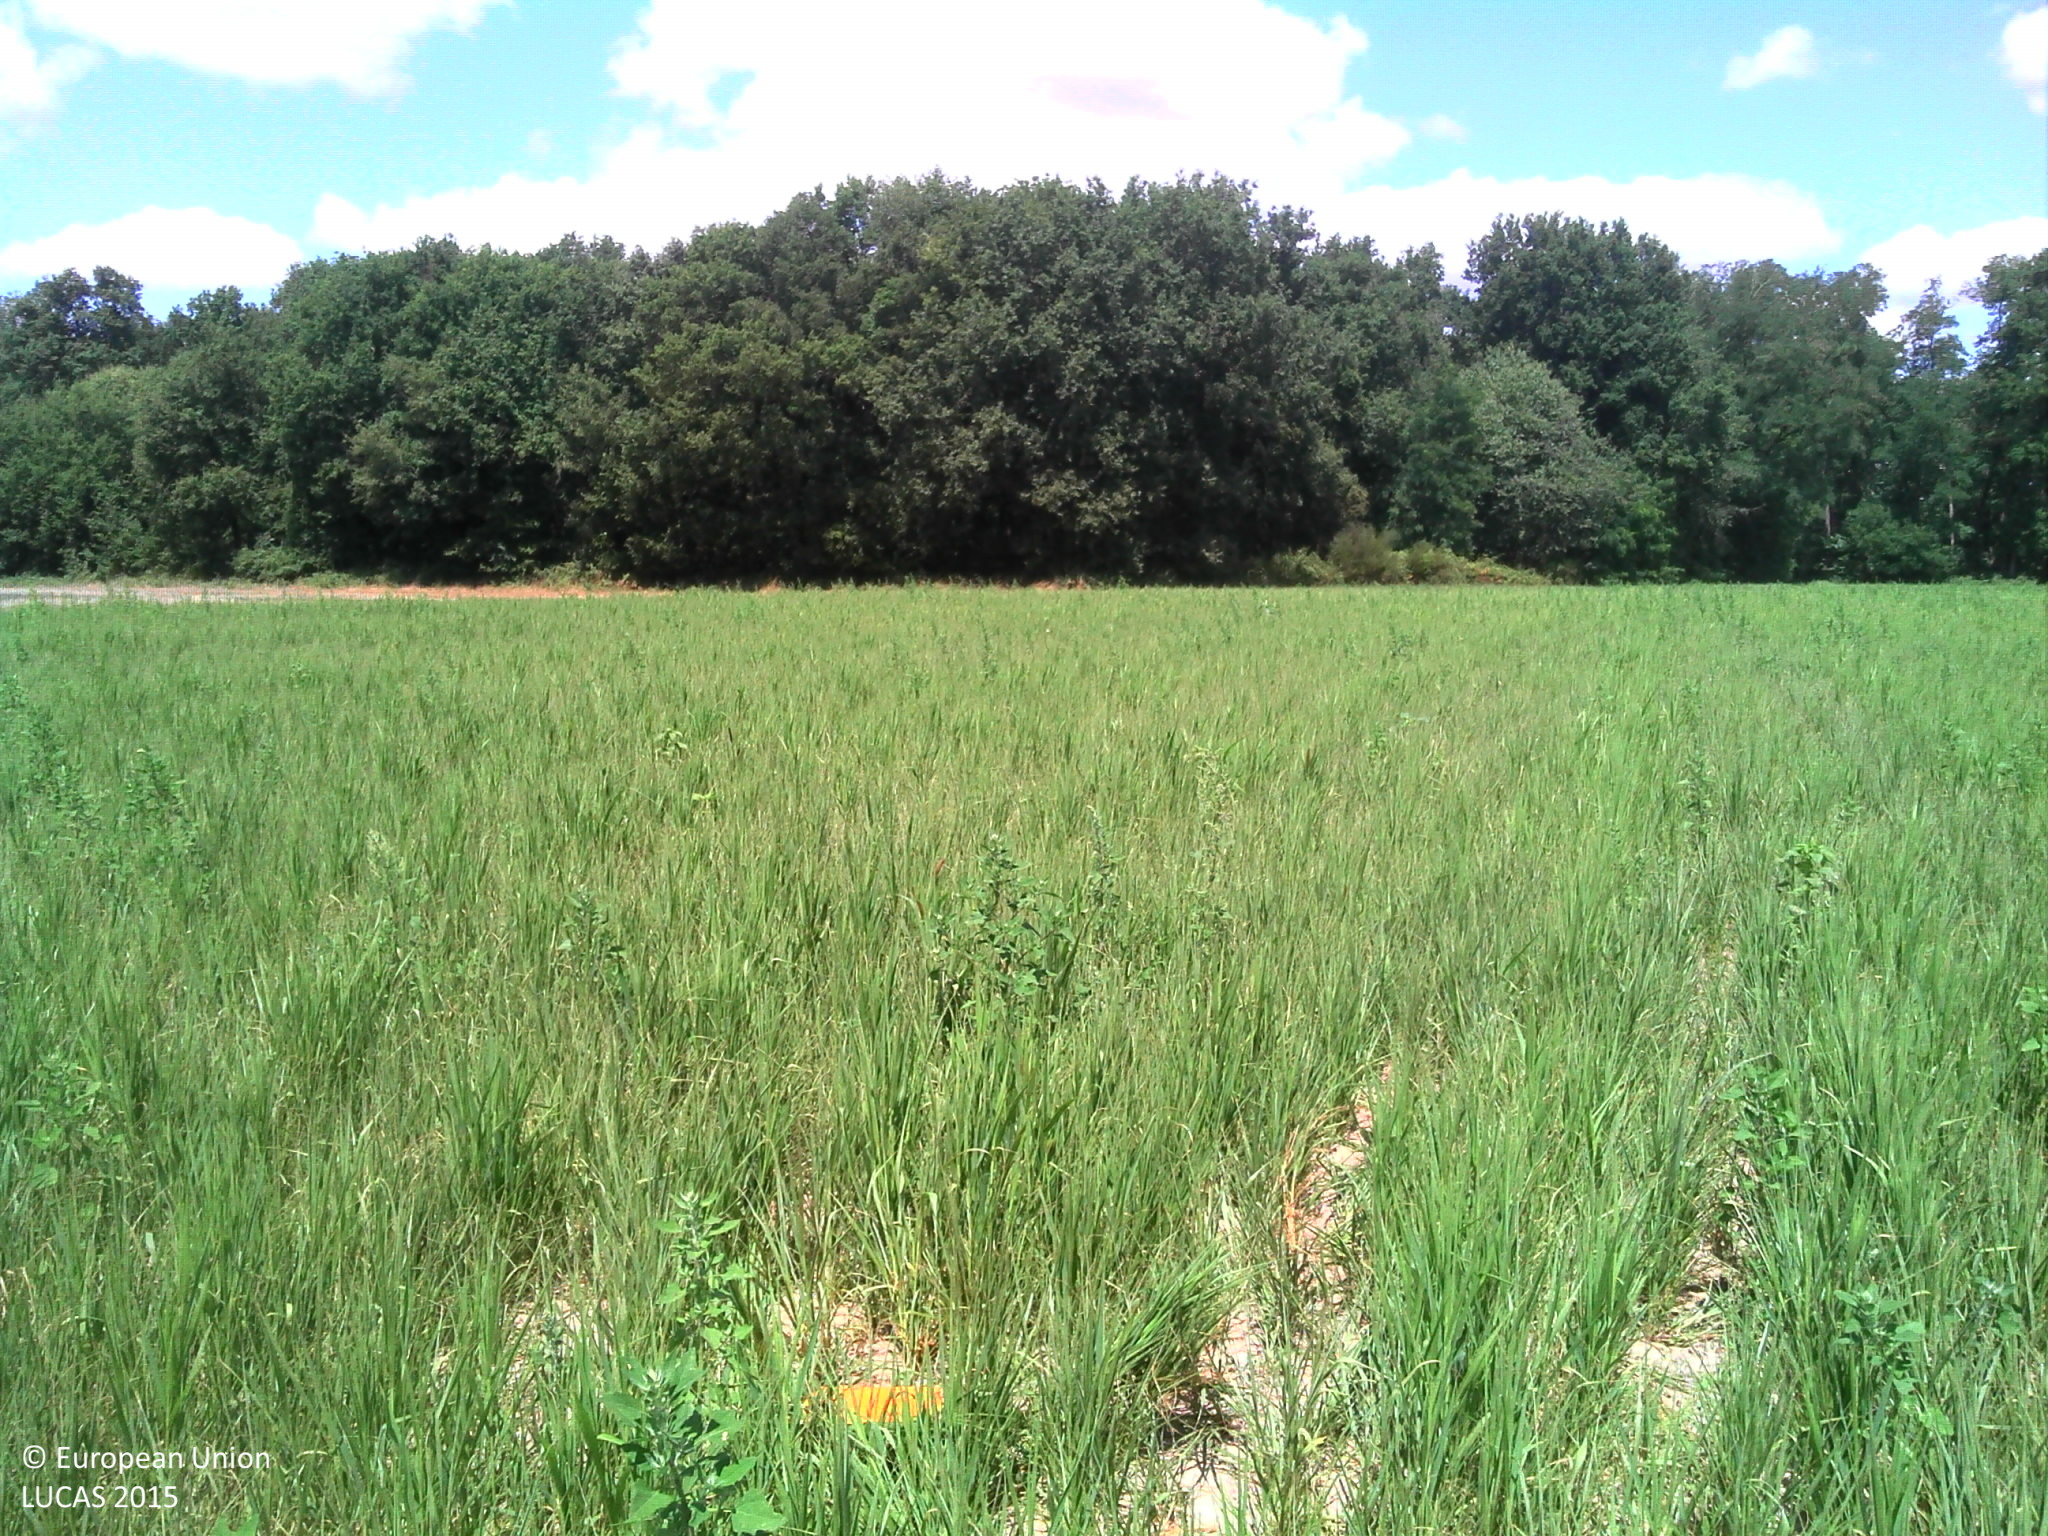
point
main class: Cropland
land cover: Temporary grasslands
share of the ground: > 75 %
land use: Agriculture (excluding fallow land and kitchen gardens)
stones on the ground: < 10 %
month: July
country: FR
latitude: 47.0412
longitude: 0.3848
